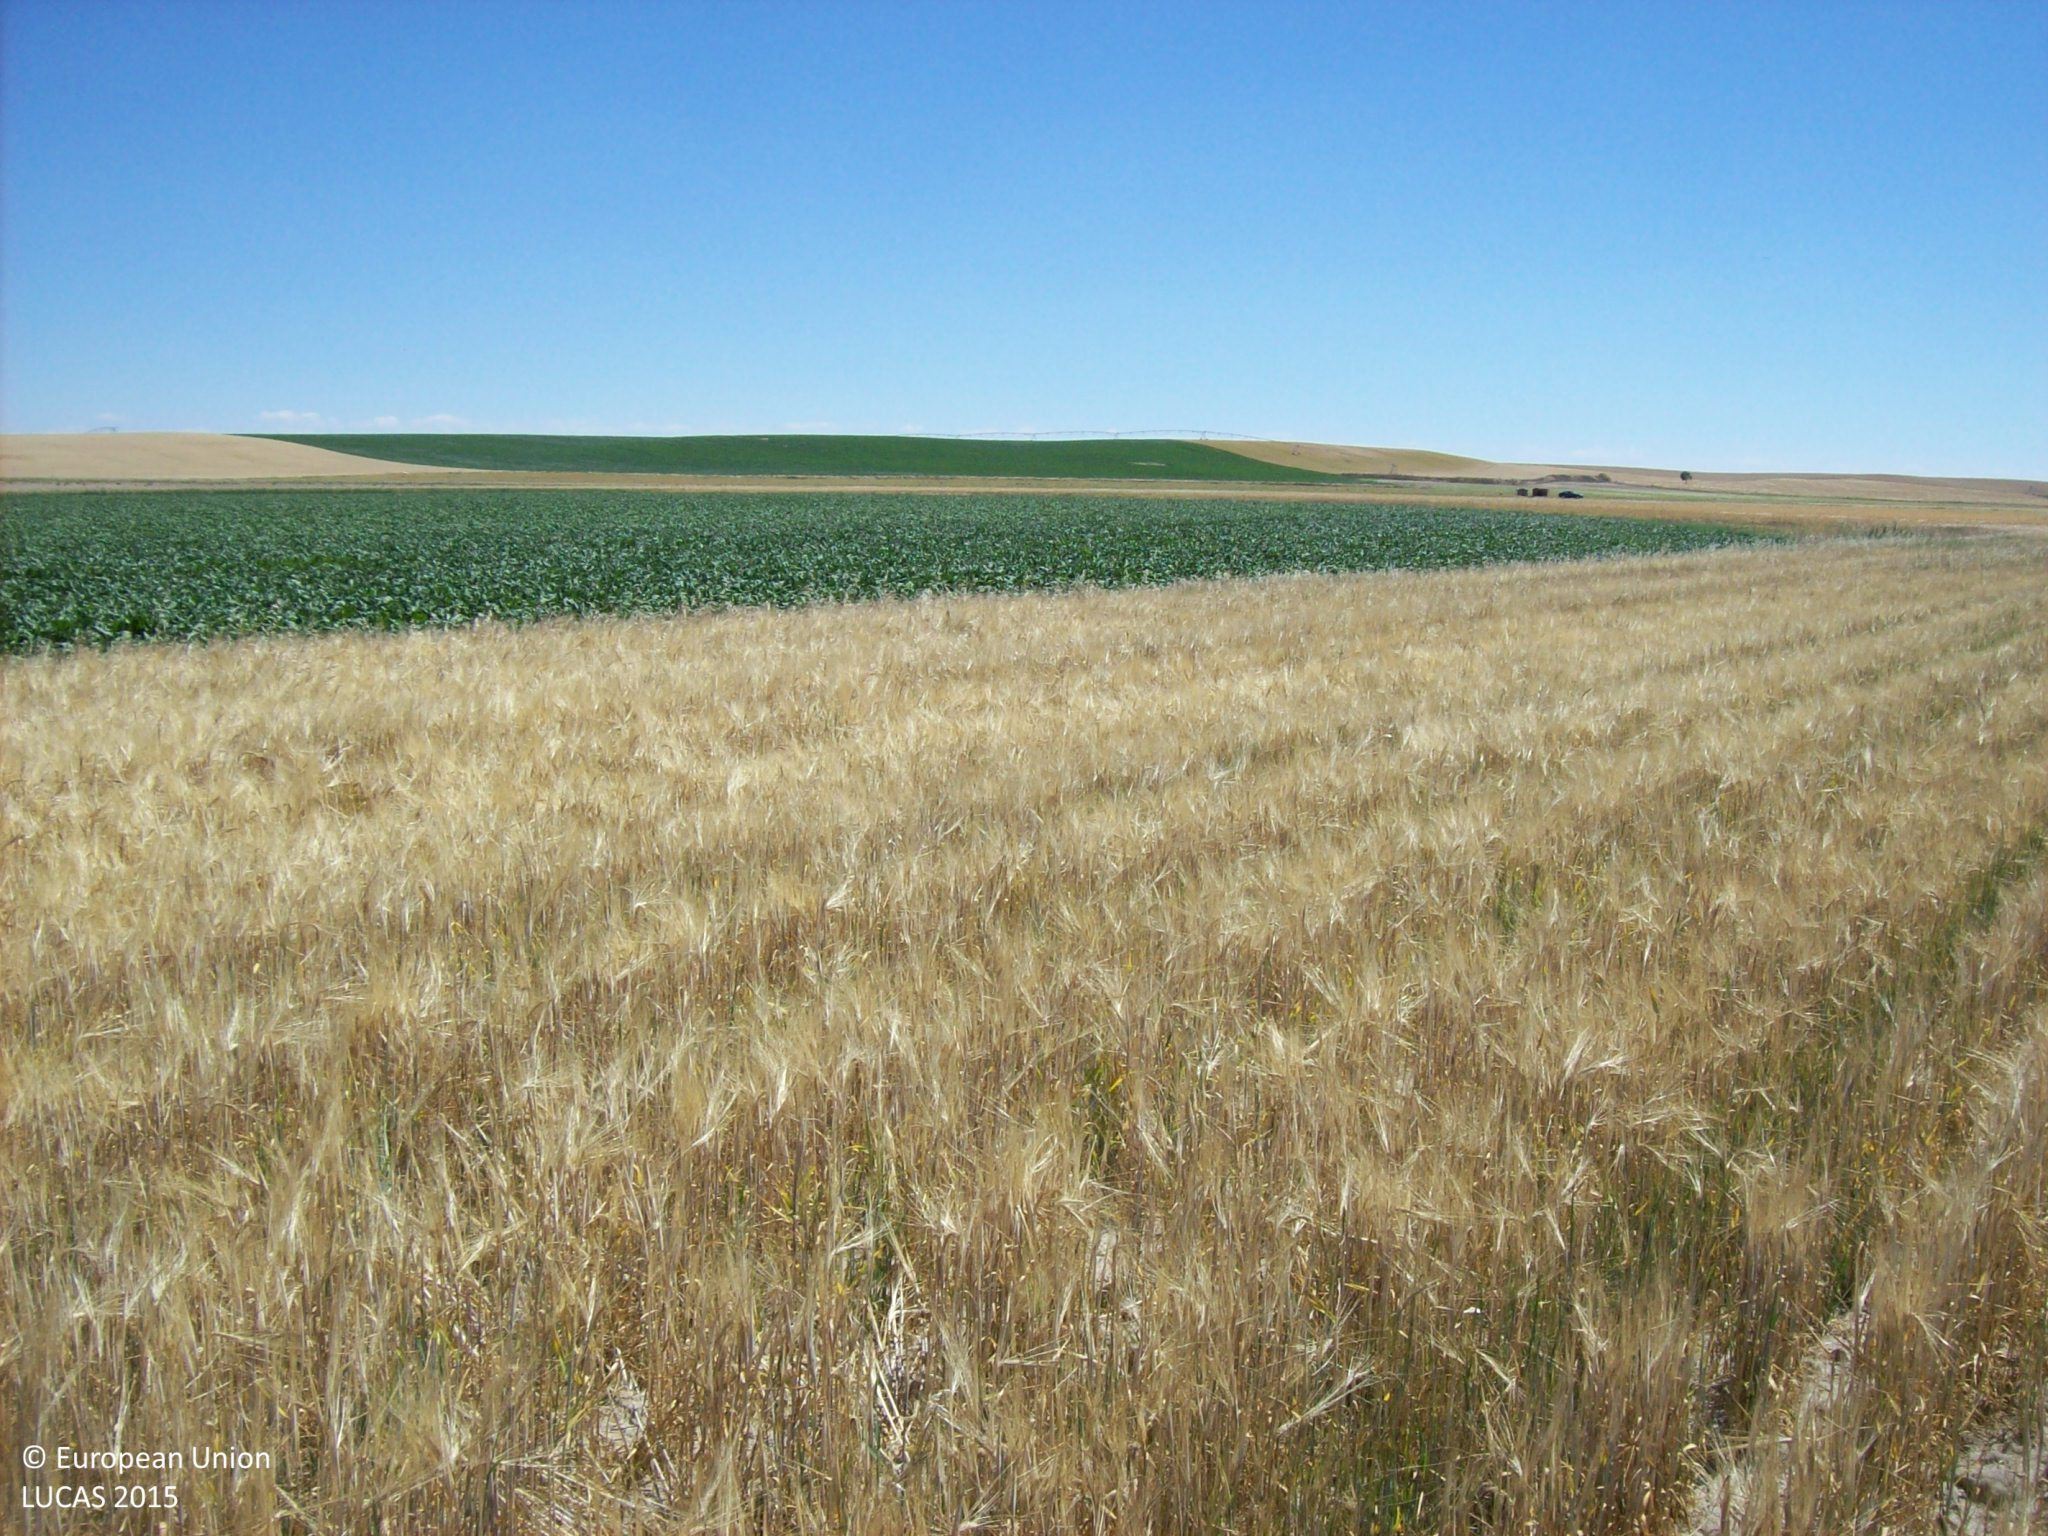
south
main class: Cropland
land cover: Barley
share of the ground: > 75 %
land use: Agriculture (excluding fallow land and kitchen gardens)
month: June
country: ES
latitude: 41.2122
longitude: -5.0371
